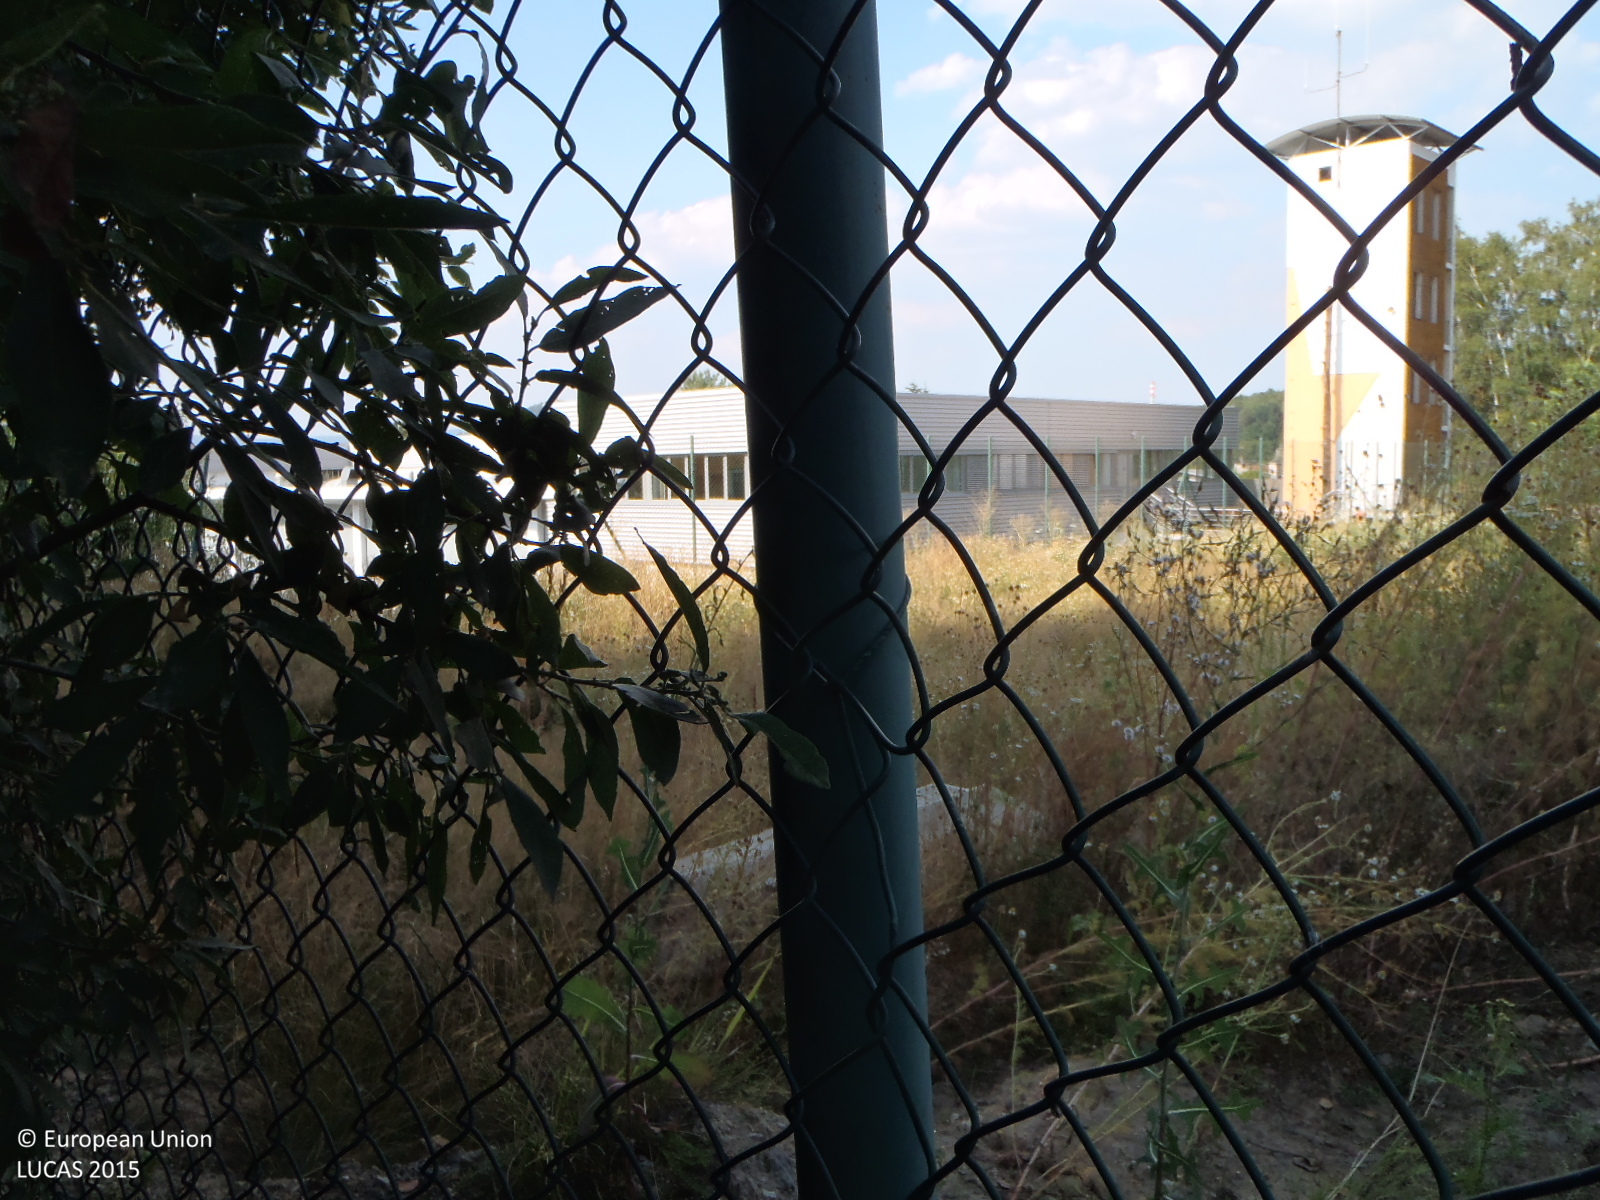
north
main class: Grassland
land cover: Spontaneously vegetated surfaces
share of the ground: > 75 %
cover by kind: herbaceous plants 95 %, unconsolidated bare surface 5 %
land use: Community services
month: August
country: CZ
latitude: 50.6700
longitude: 14.5438
